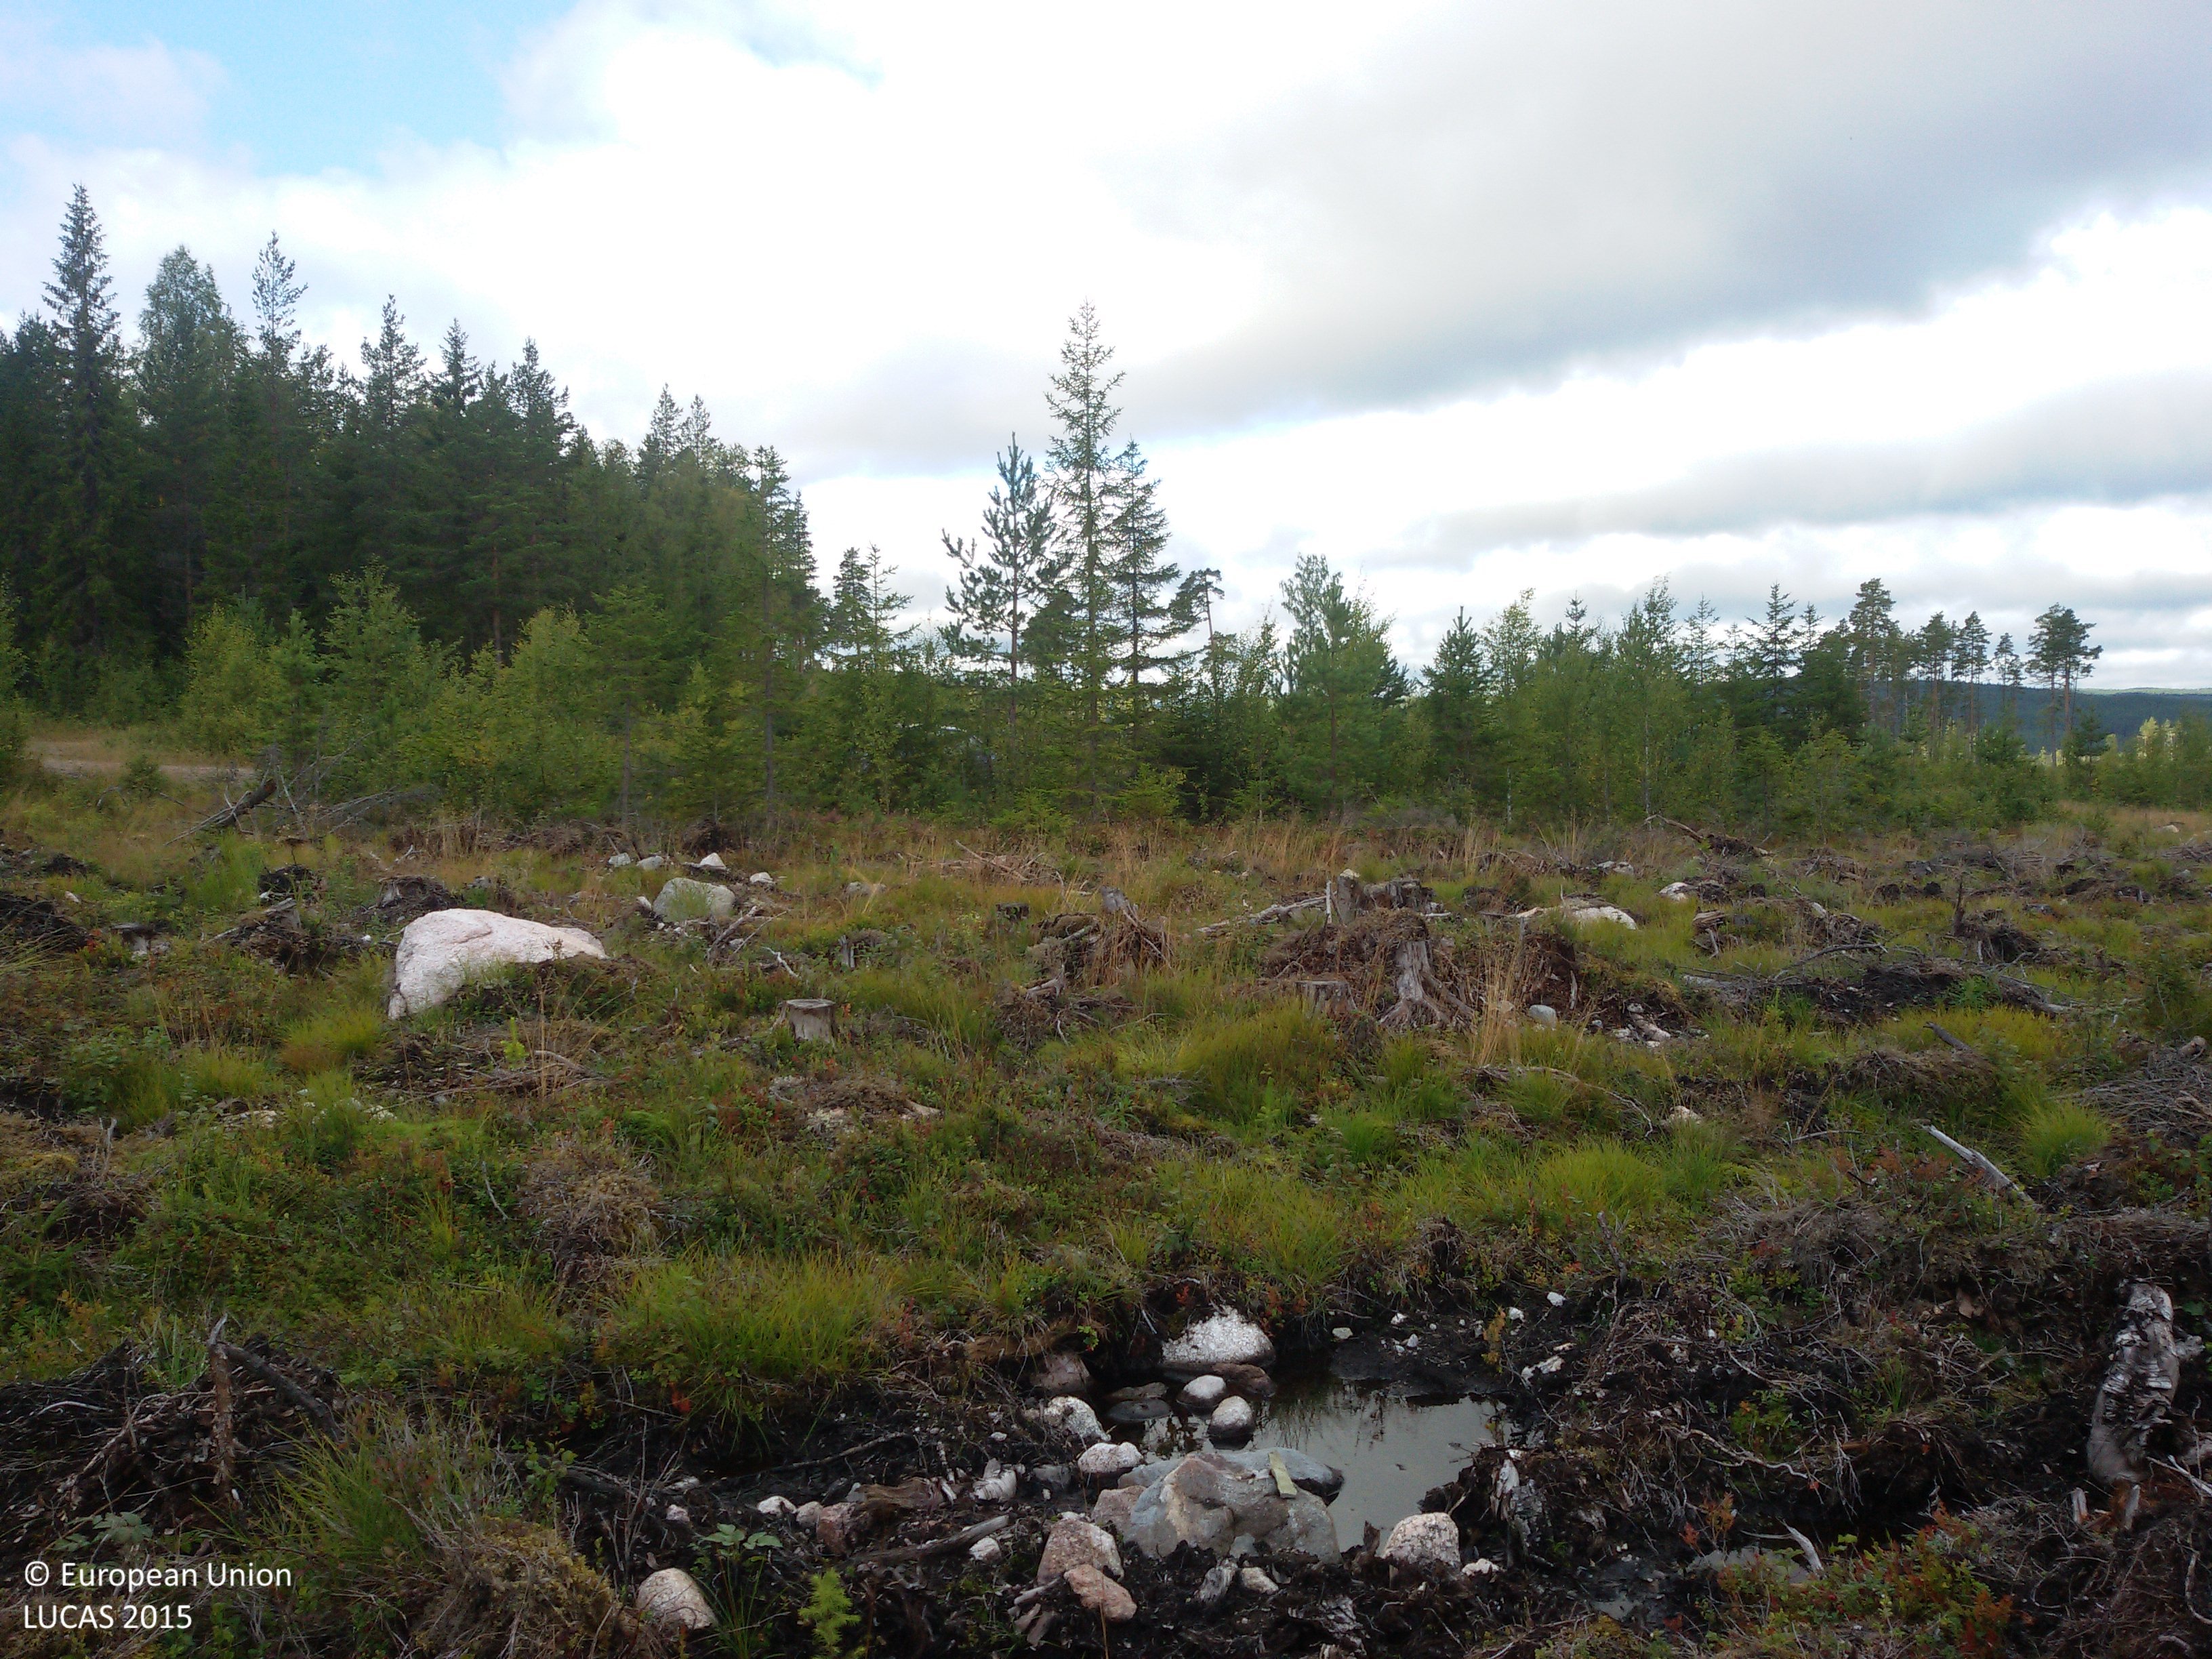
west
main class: Shrubland
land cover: Shrubland without tree cover
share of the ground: 10 - 25 %
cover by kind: herbaceous plants 40 %, lichens and mosses 30 %, unconsolidated bare surface 20 %, shrubs 10 %
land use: Forestry
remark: Clear cut
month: September
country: SE
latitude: 61.0158
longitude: 15.4063
